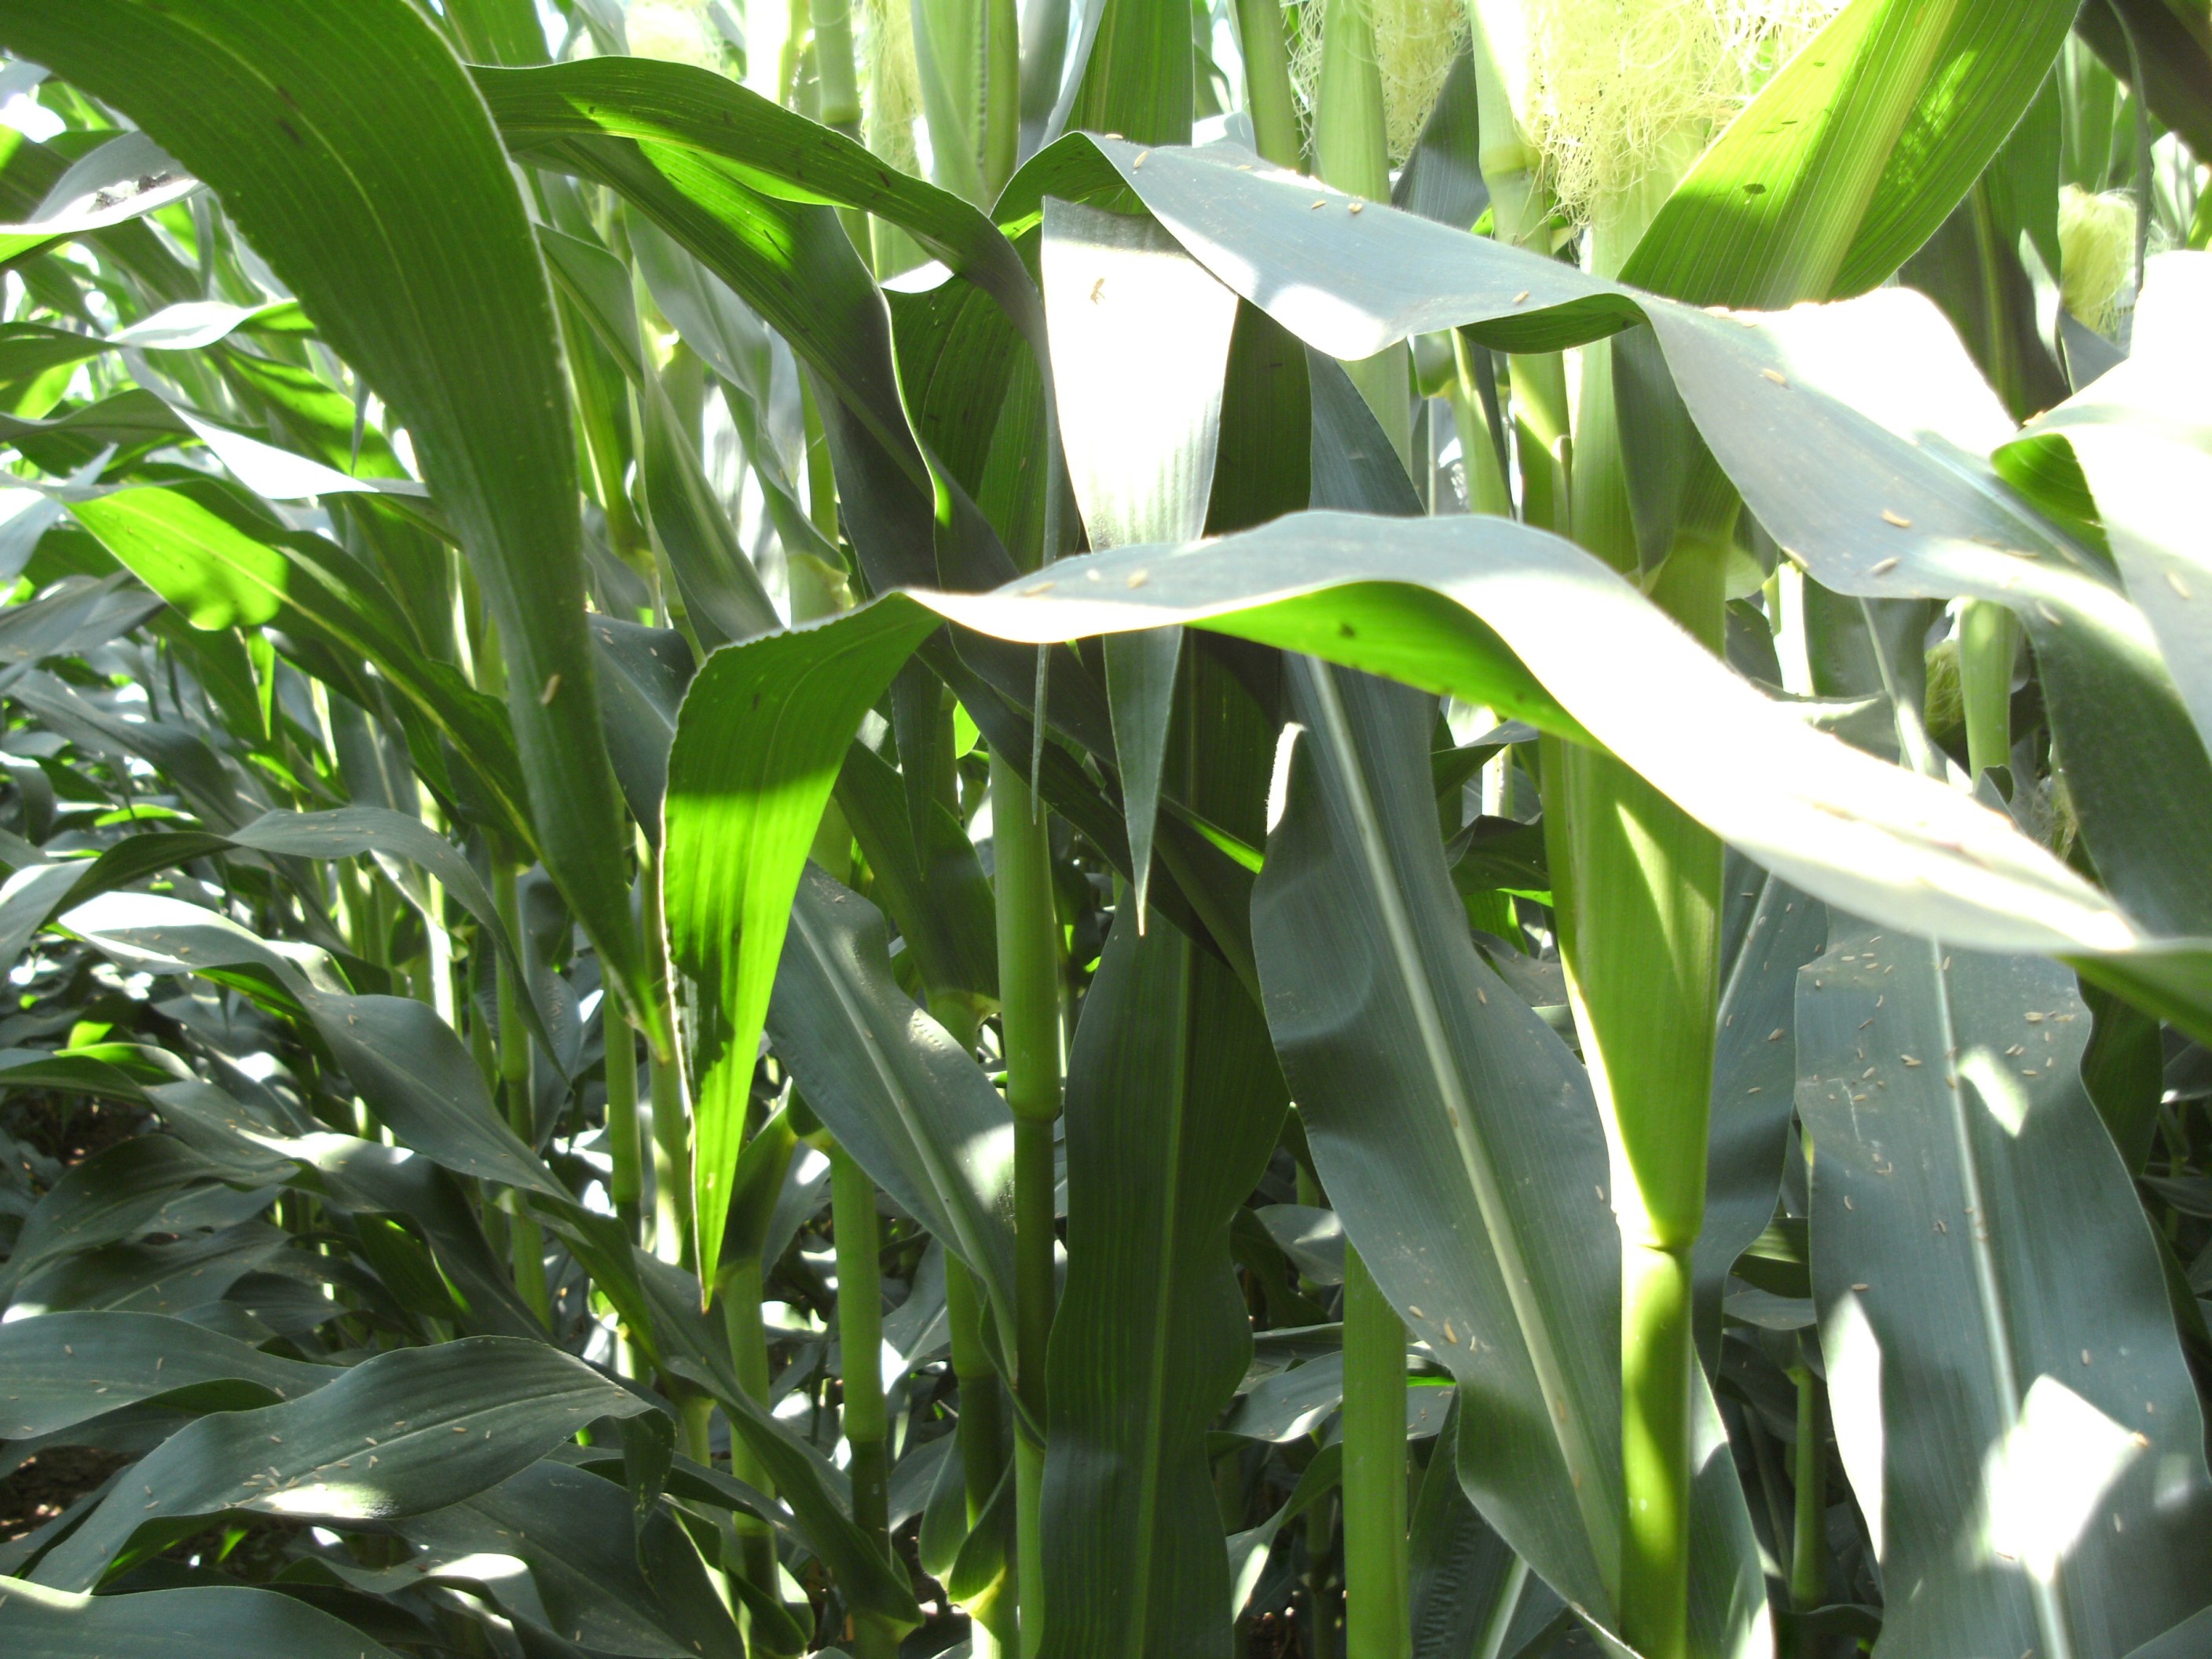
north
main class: Cropland
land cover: Maize
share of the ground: > 75 %
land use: Agriculture (excluding fallow land and kitchen gardens)
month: July
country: AT
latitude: 46.7833
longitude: 14.8316
